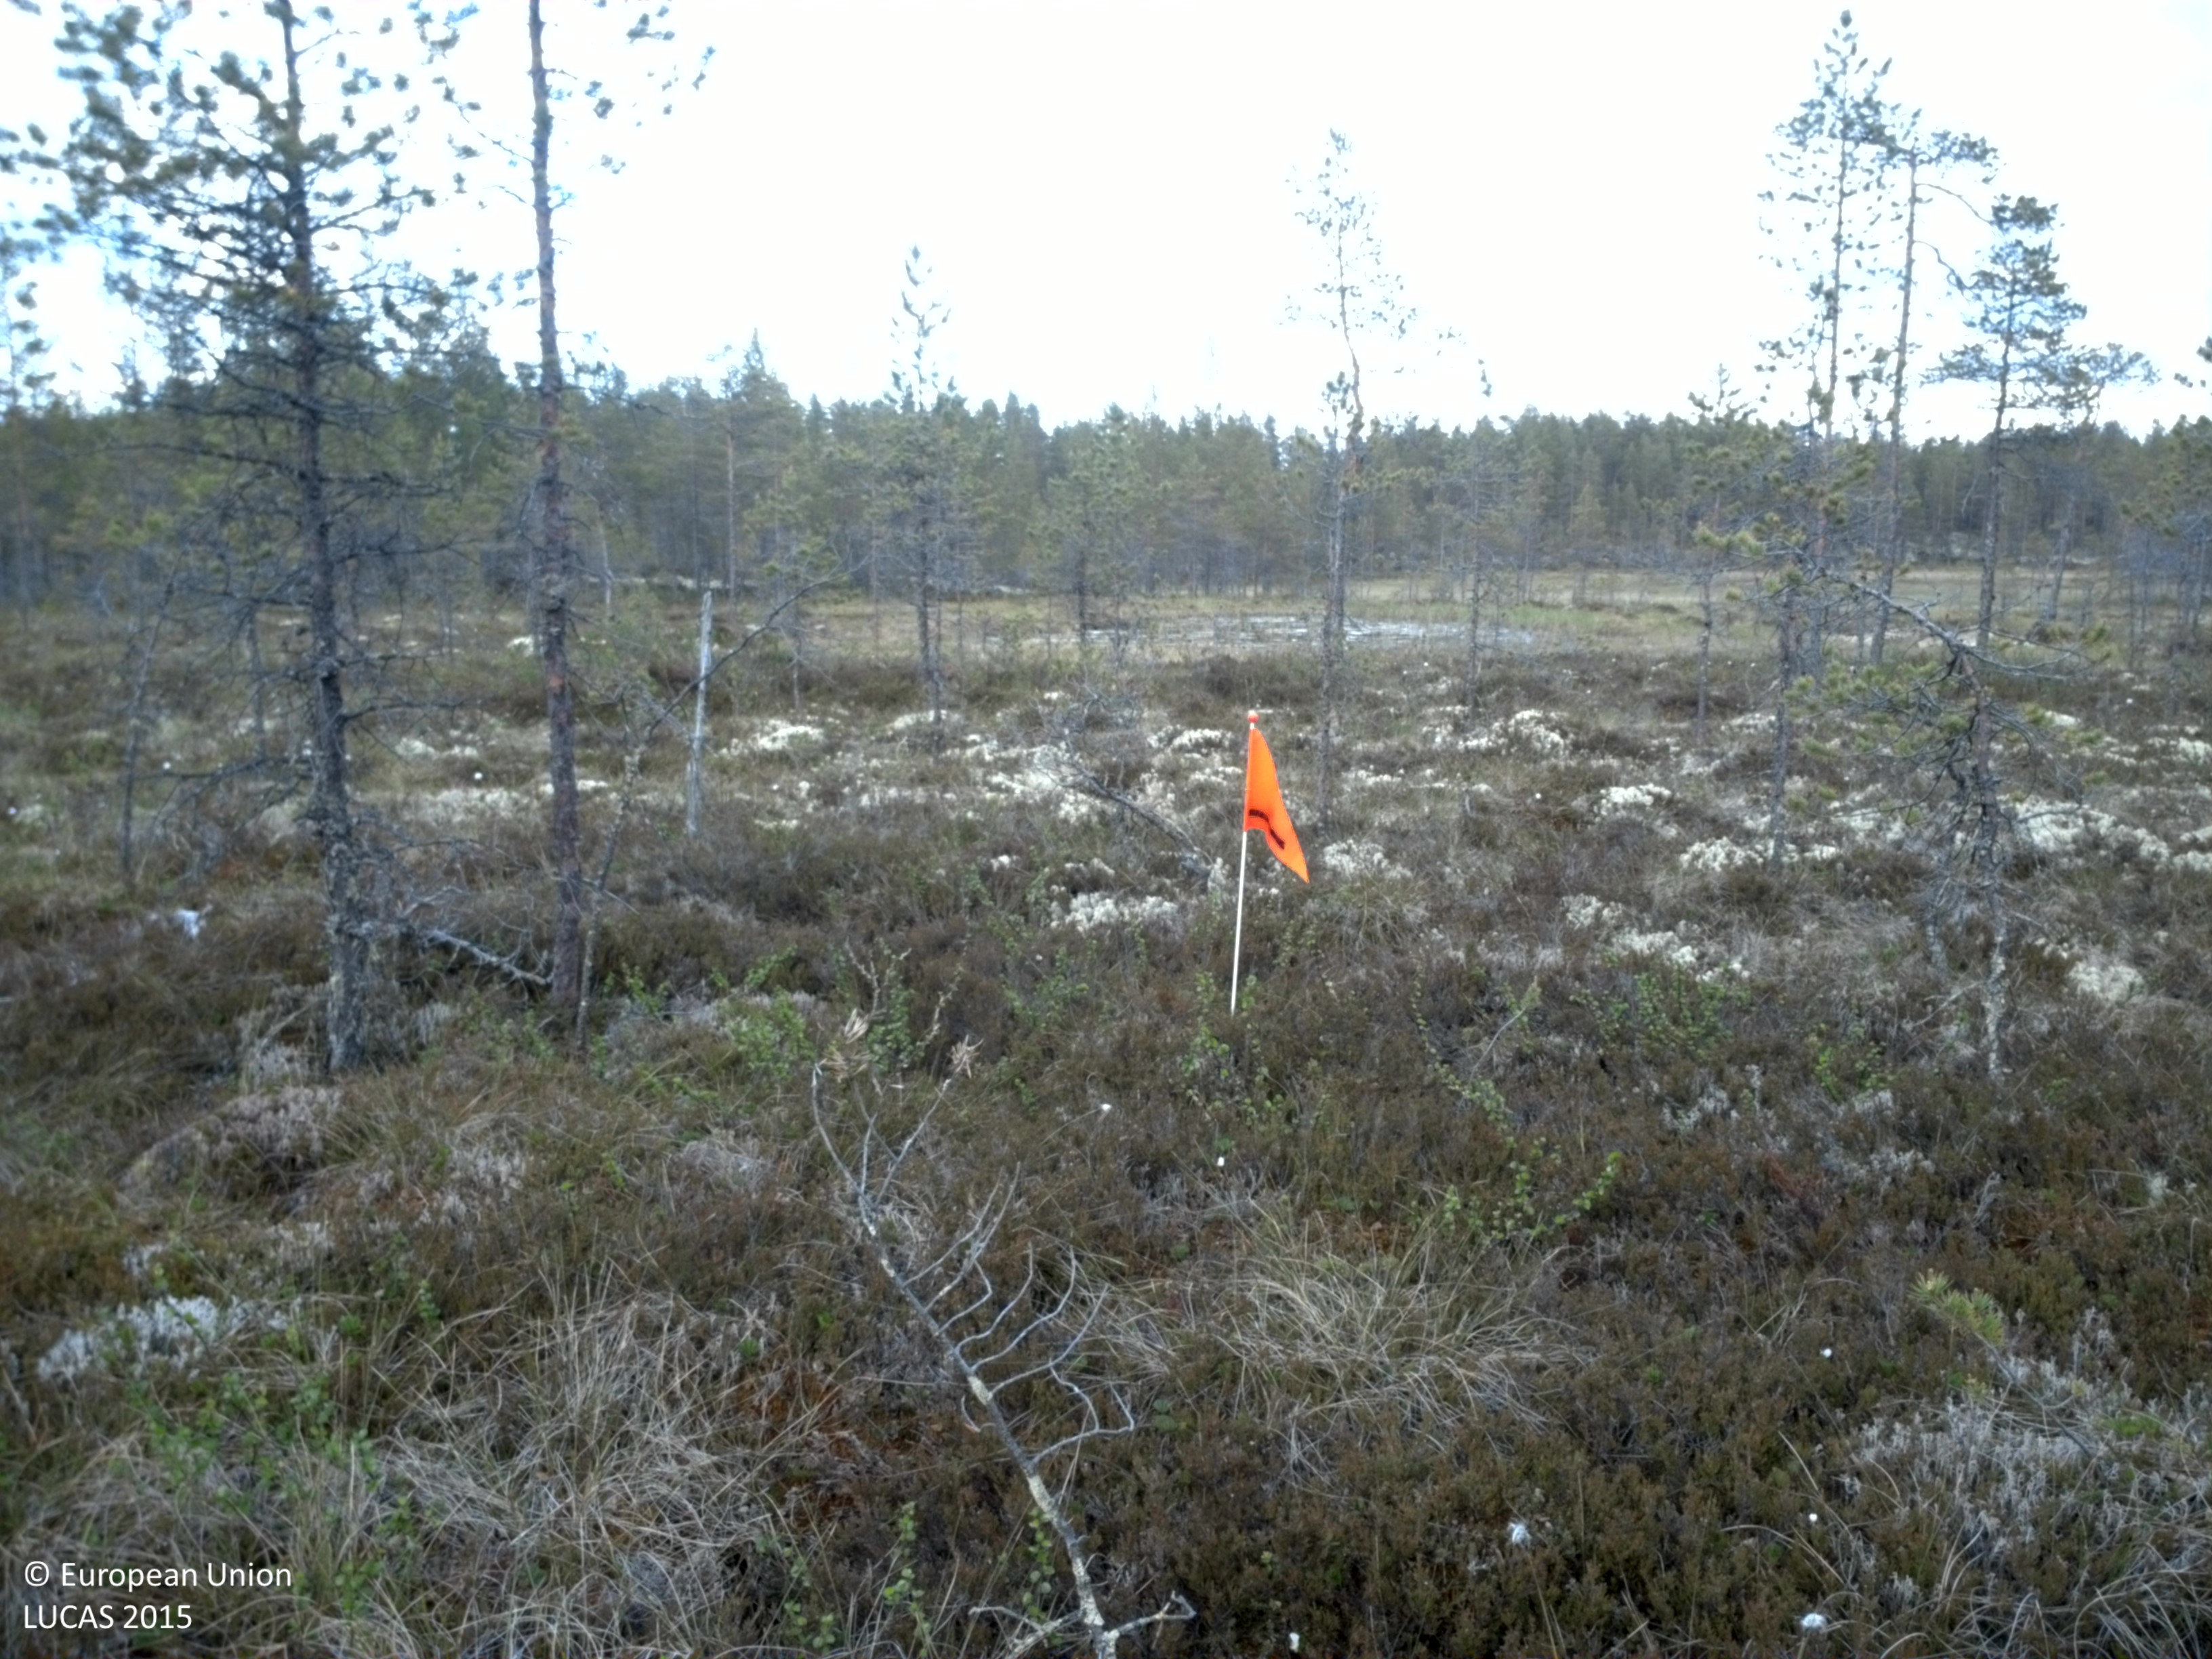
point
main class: Woodland
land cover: Pine dominated coniferous woodland
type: boreal forest
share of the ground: 25 - 50 %
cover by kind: lichens and mosses 50 %, coniferous forest trees 35 %, herbaceous plants 15 %
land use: Semi-natural and natural areas not in use
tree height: < 5 m
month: June
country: SE
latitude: 61.2509
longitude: 13.6592
